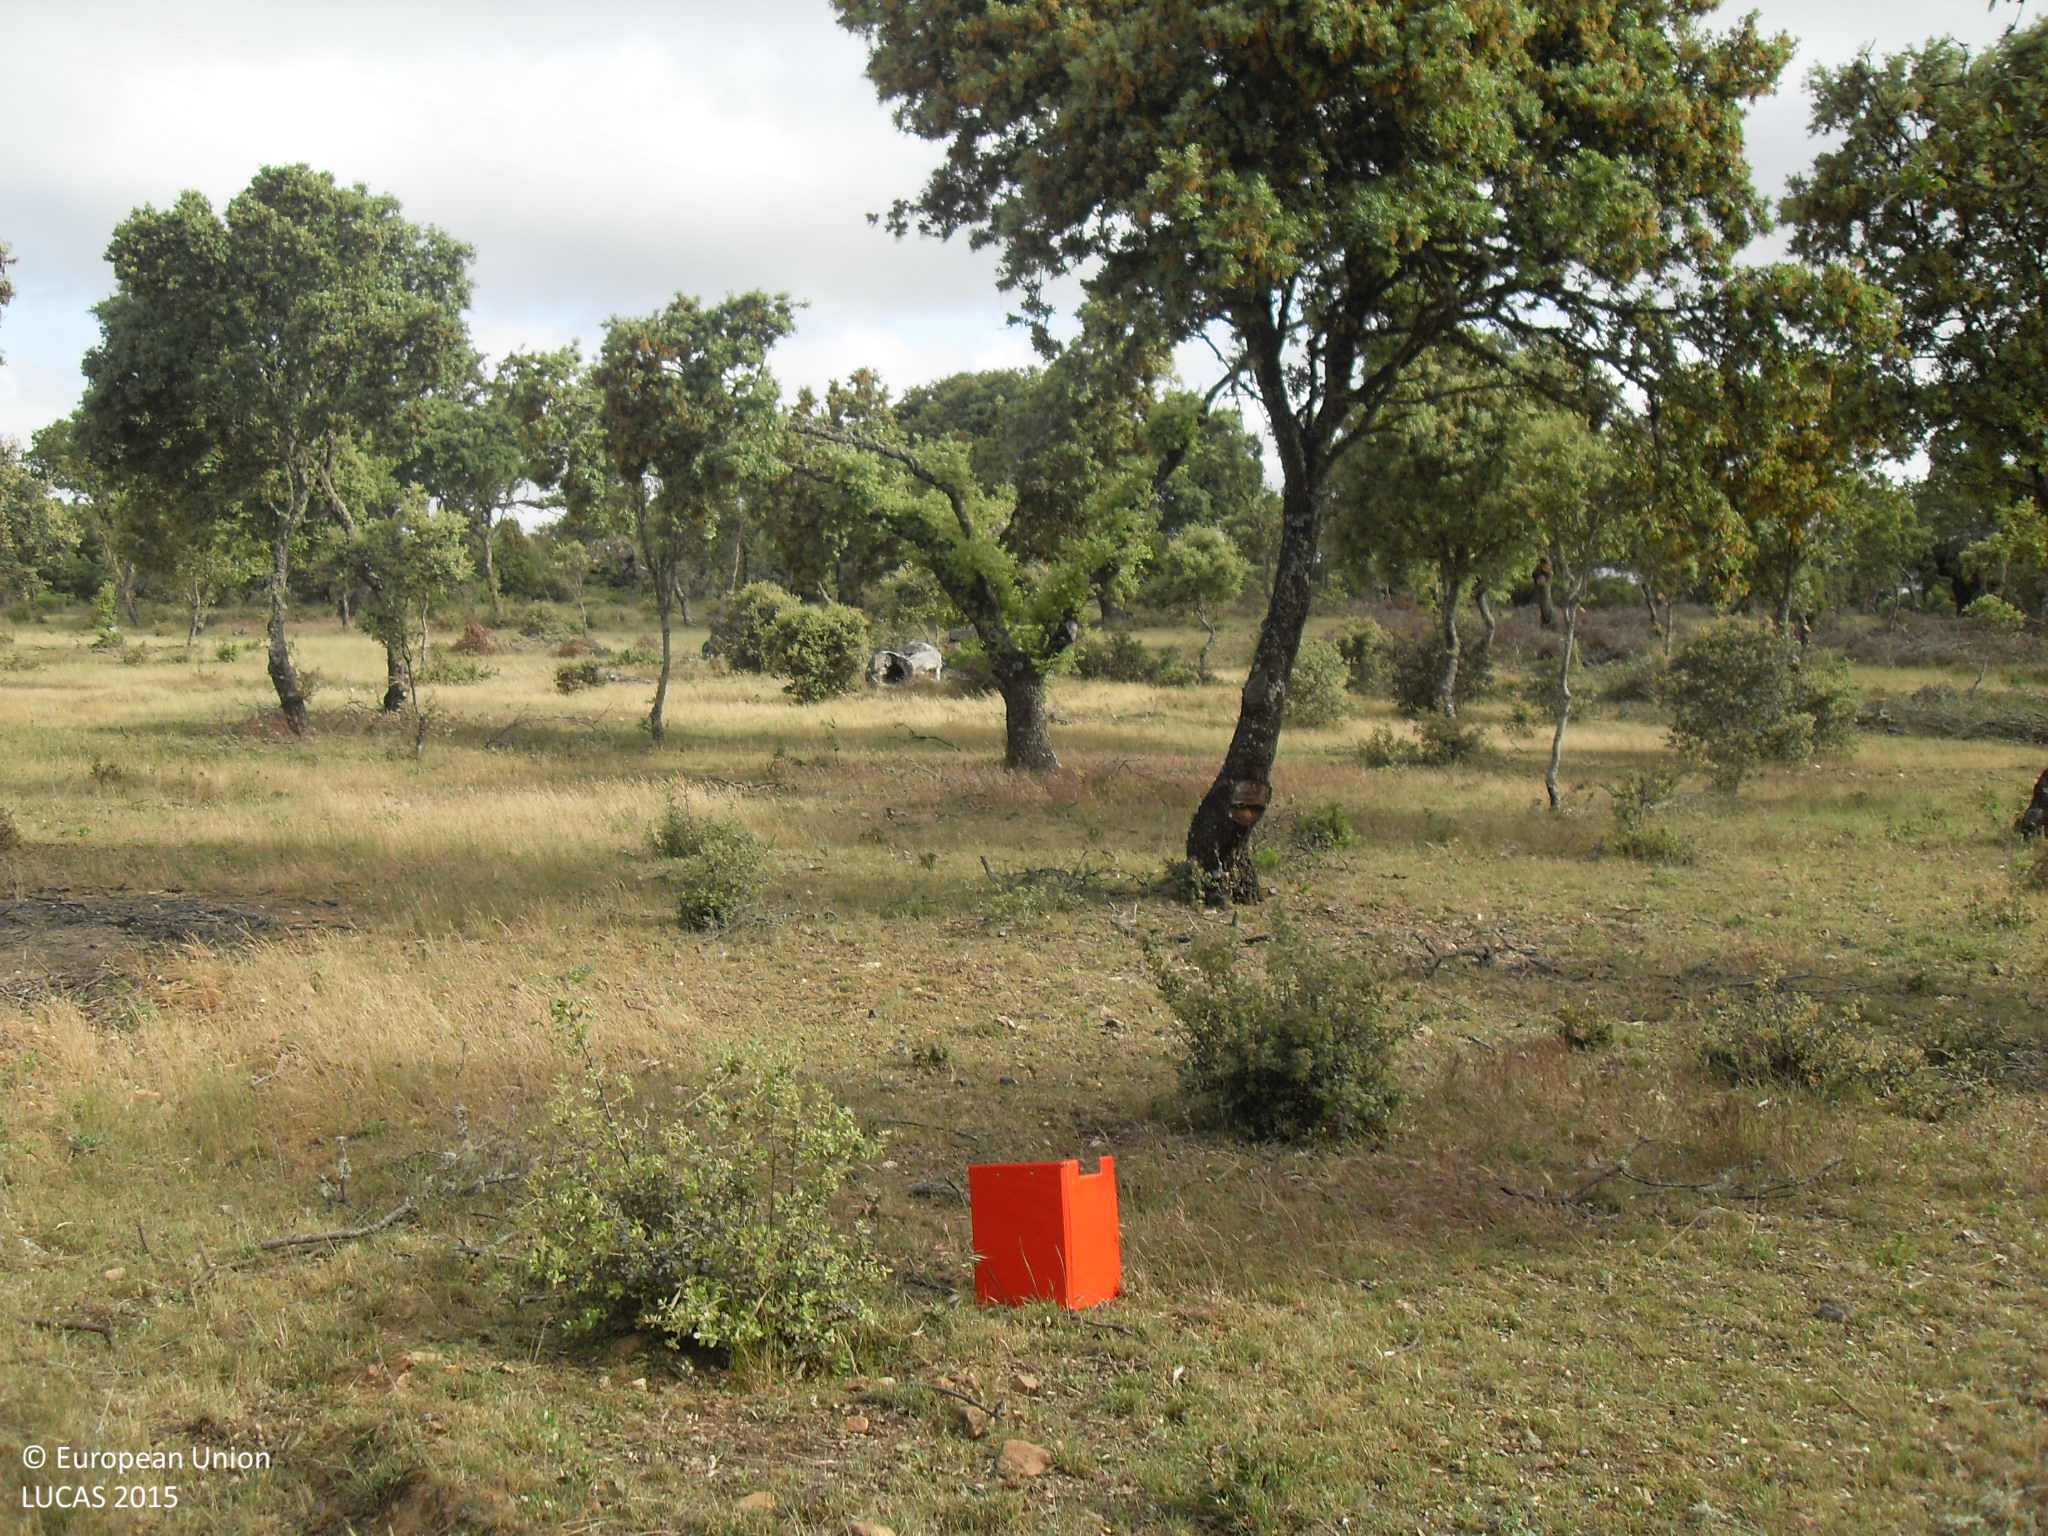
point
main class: Woodland
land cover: Broadleaved woodland
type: broadleaved evergreen forest
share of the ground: > 75 %
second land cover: Grassland without tree/shrub cover
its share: 10 - 25 %
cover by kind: broadleaved forest trees 80 %, herbaceous plants 20 %
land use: Forestry
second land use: Agriculture (excluding fallow land and kitchen gardens)
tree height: > 5 m
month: May
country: ES
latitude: 40.7317
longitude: -5.6438
